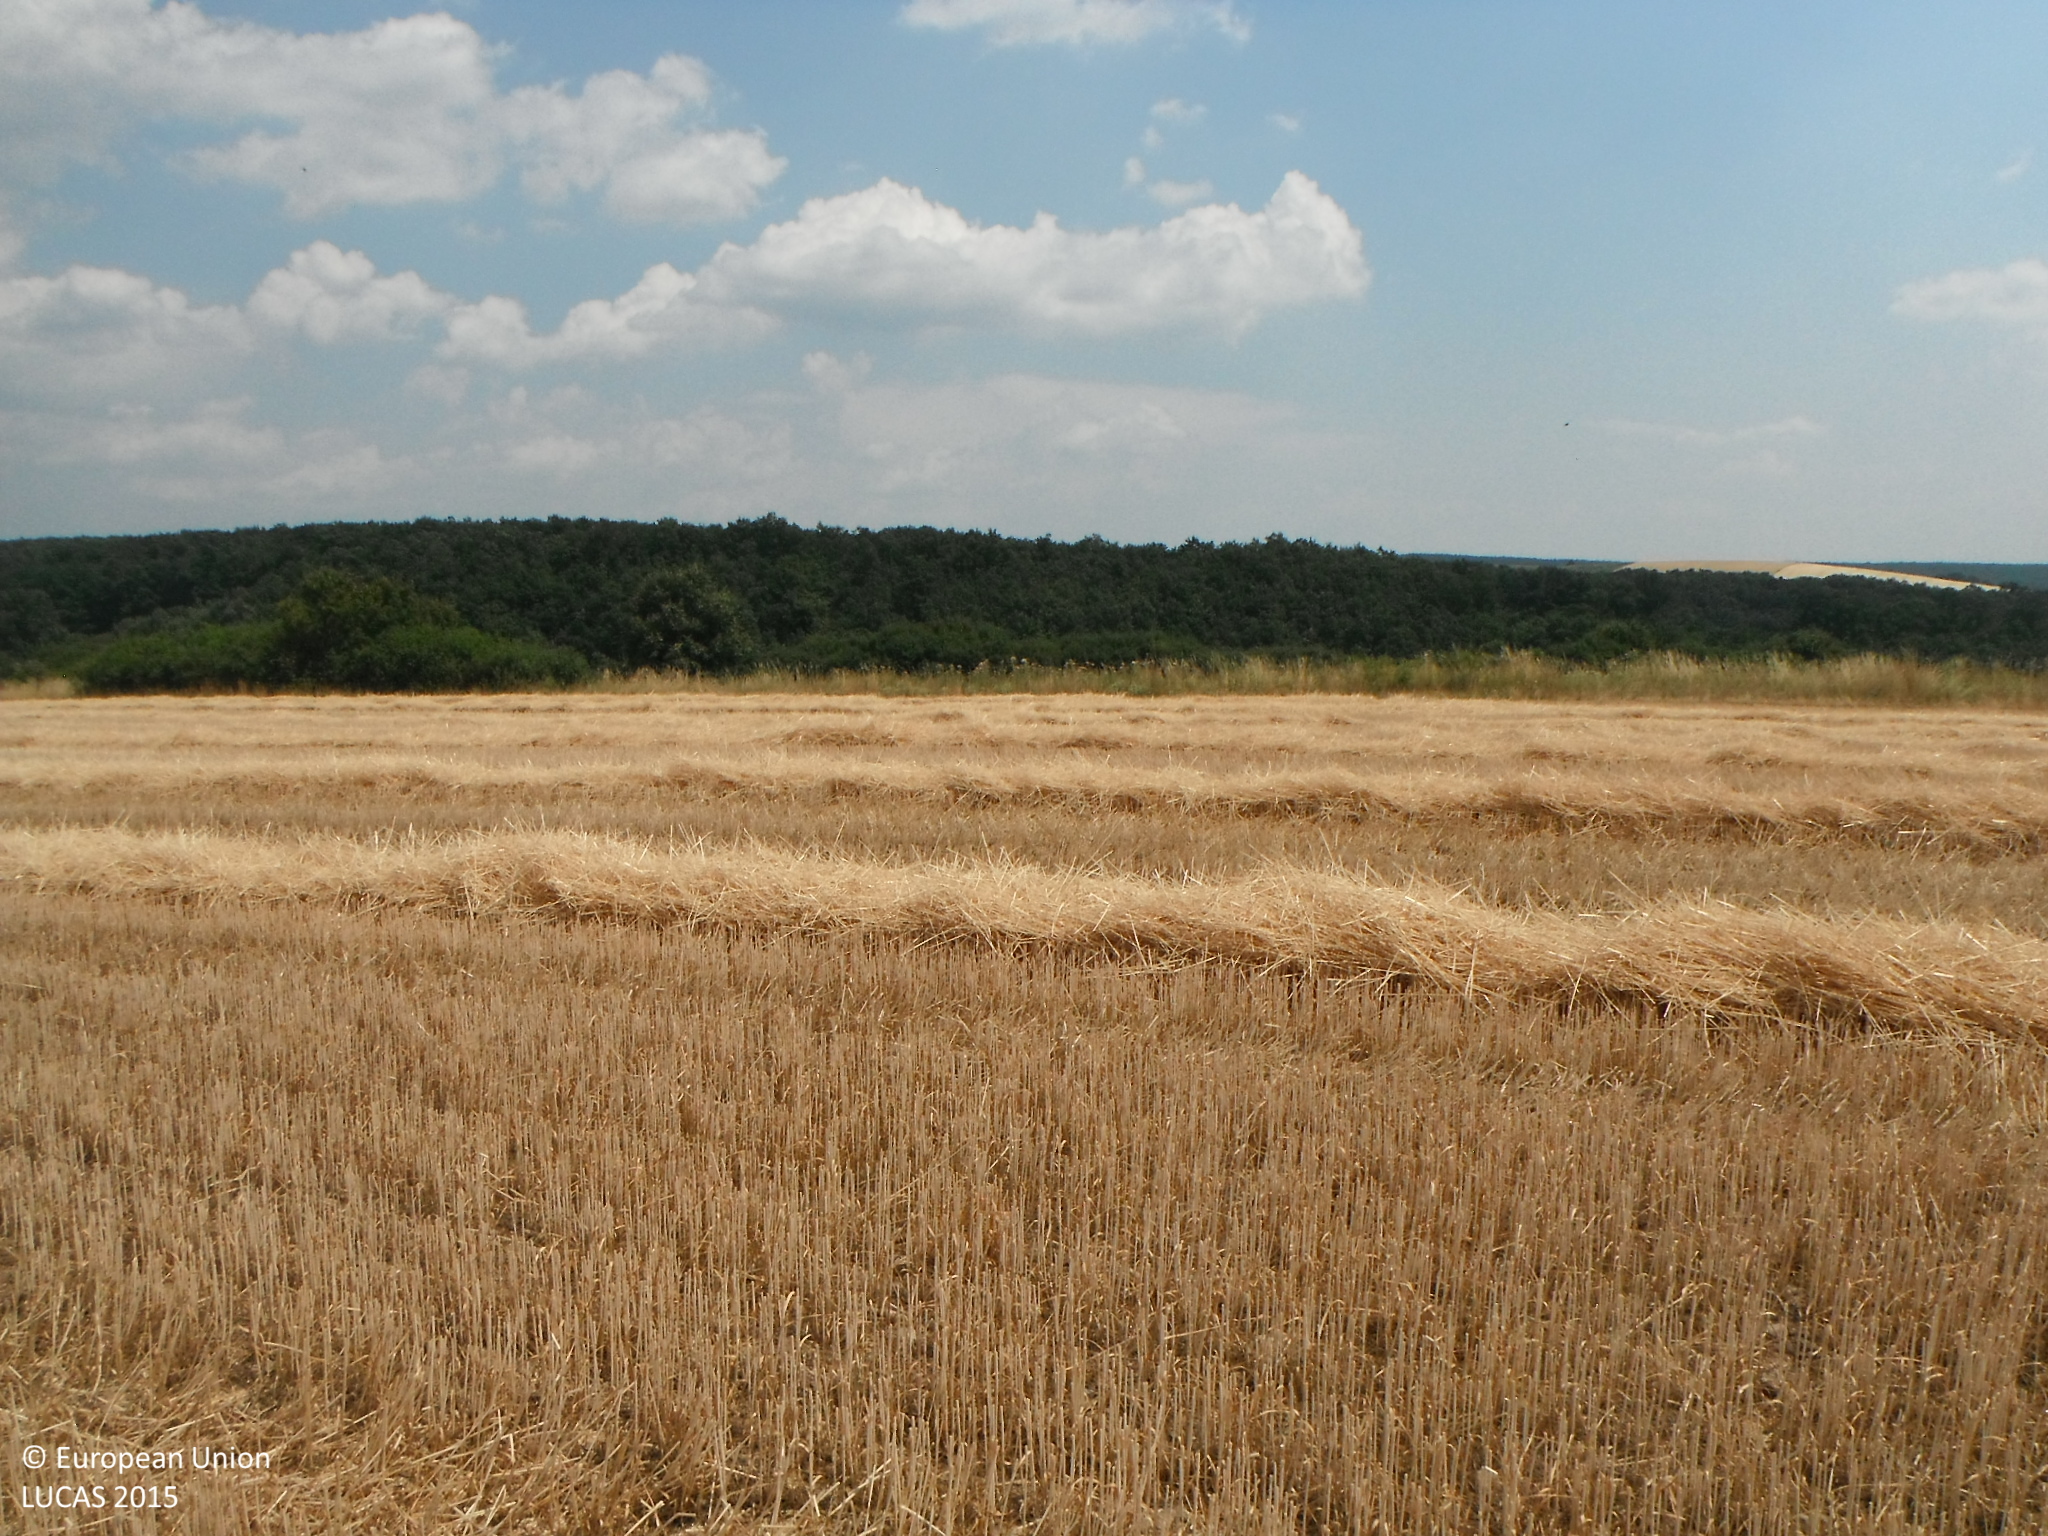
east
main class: Cropland
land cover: Common wheat
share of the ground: > 75 %
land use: Agriculture (excluding fallow land and kitchen gardens)
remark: Harvested field
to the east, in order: Common wheat; Tracks; Grass margins; Common wheat; Shrubland with sparse tree cover; Broadleaved woodland
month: July
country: SK
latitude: 48.3510
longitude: 19.1299
